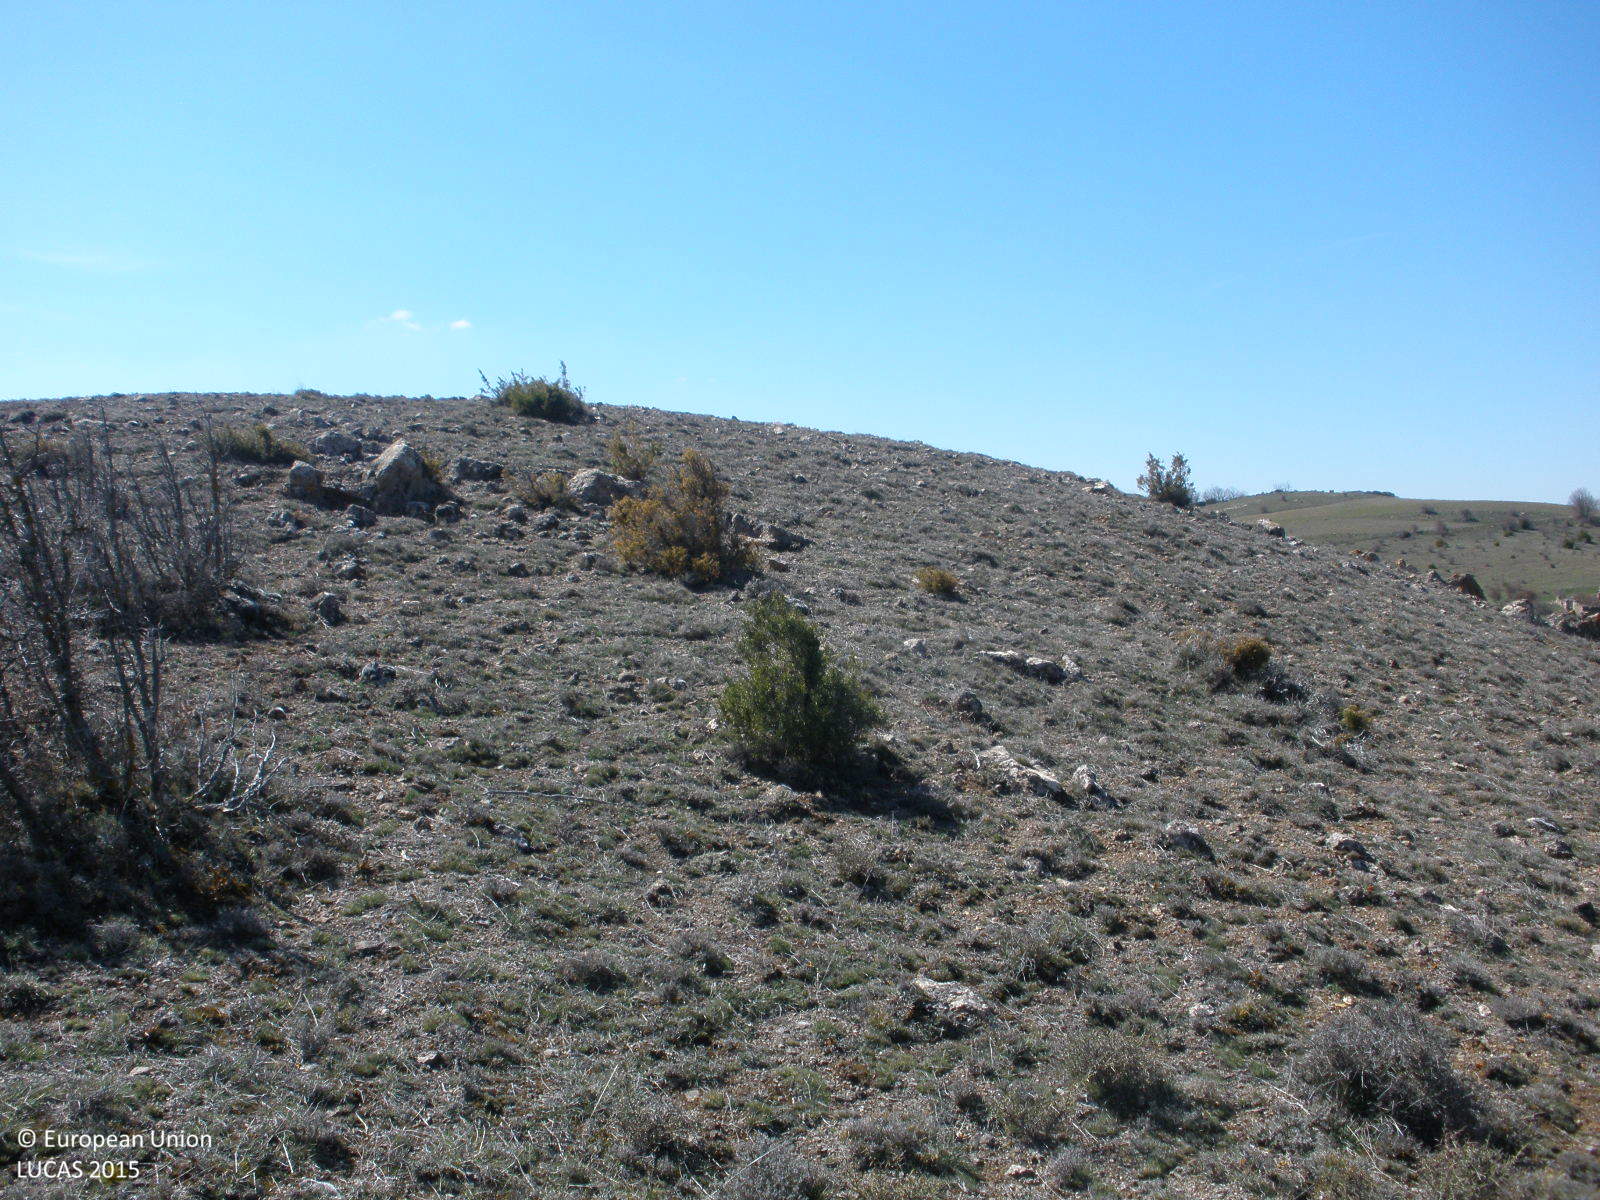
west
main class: Shrubland
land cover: Shrubland without tree cover
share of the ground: 50 - 75 %
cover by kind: shrubs 70 %, consolidated bare surface 30 %
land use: Semi-natural and natural areas not in use
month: April
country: ES
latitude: 40.9818
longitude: -1.1300
